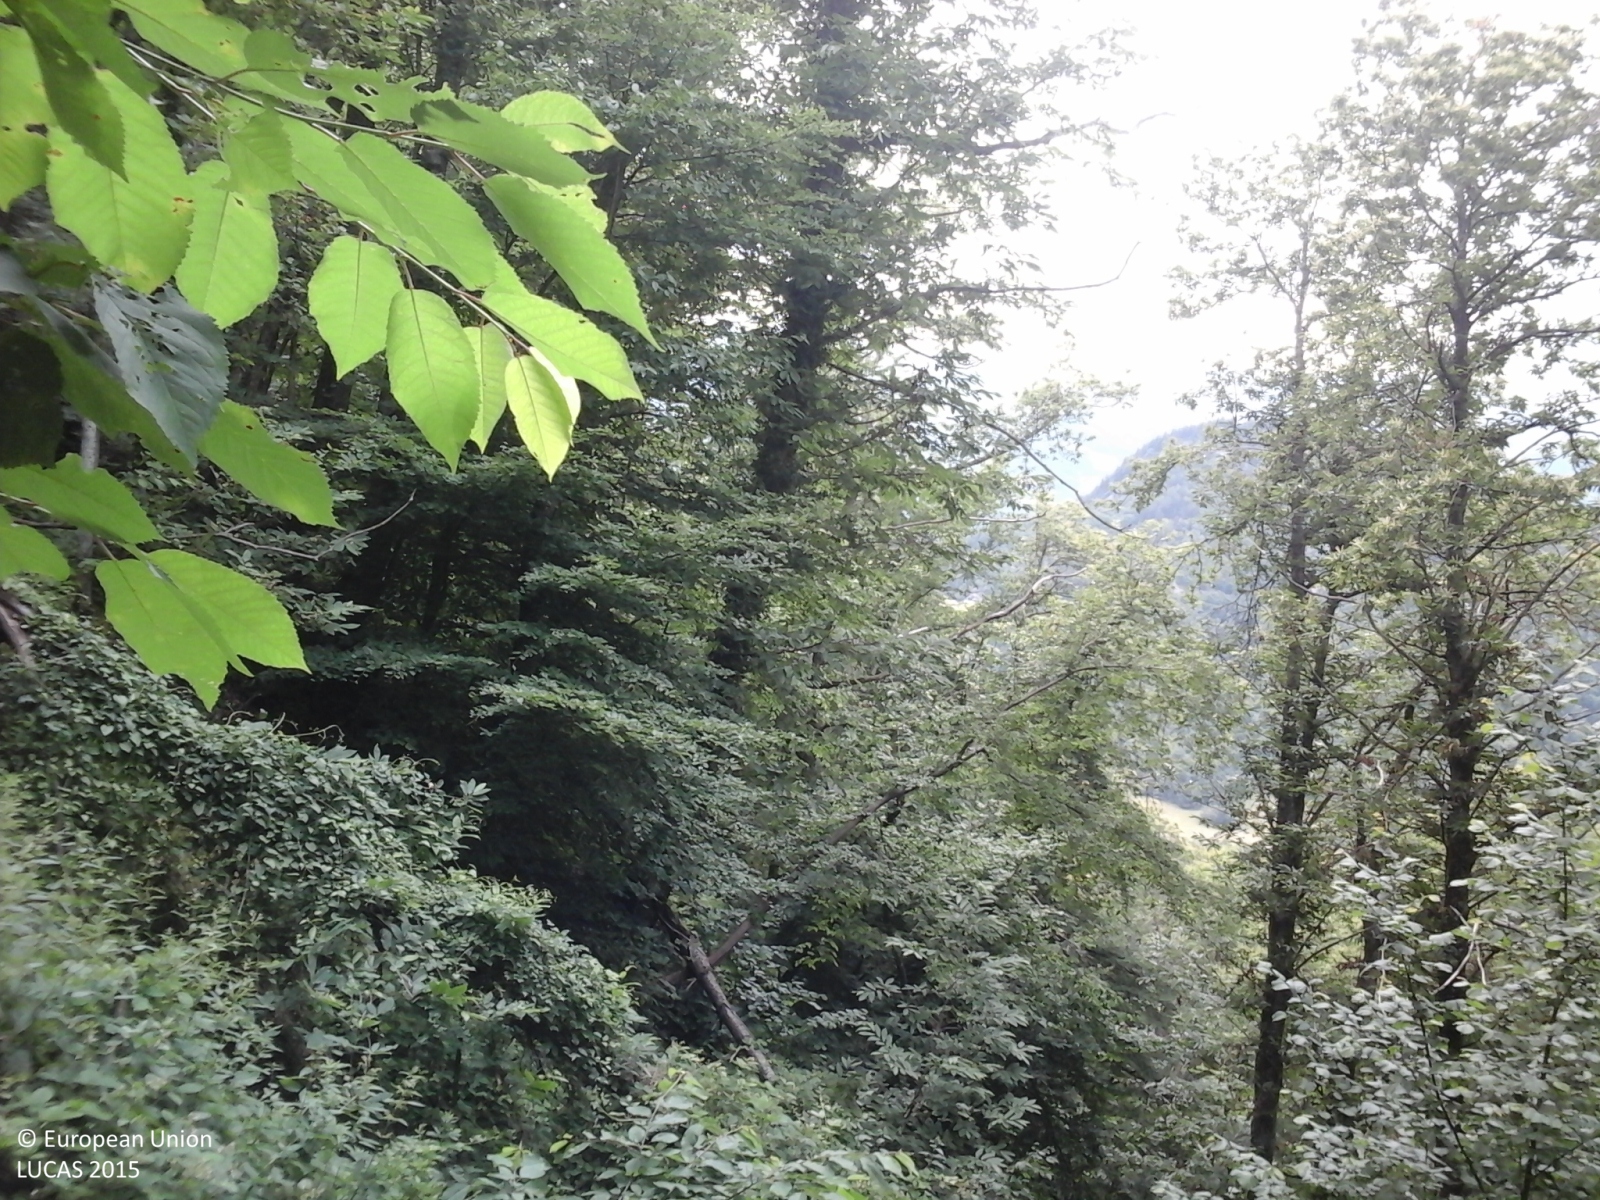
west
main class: Woodland
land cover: Broadleaved woodland
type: thermophilous deciduous forest
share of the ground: > 75 %
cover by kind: broadleaved forest trees 100 %
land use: Forestry
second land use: Other primary production
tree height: > 5 m
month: June
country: IT
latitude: 42.8334
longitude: 13.3546
